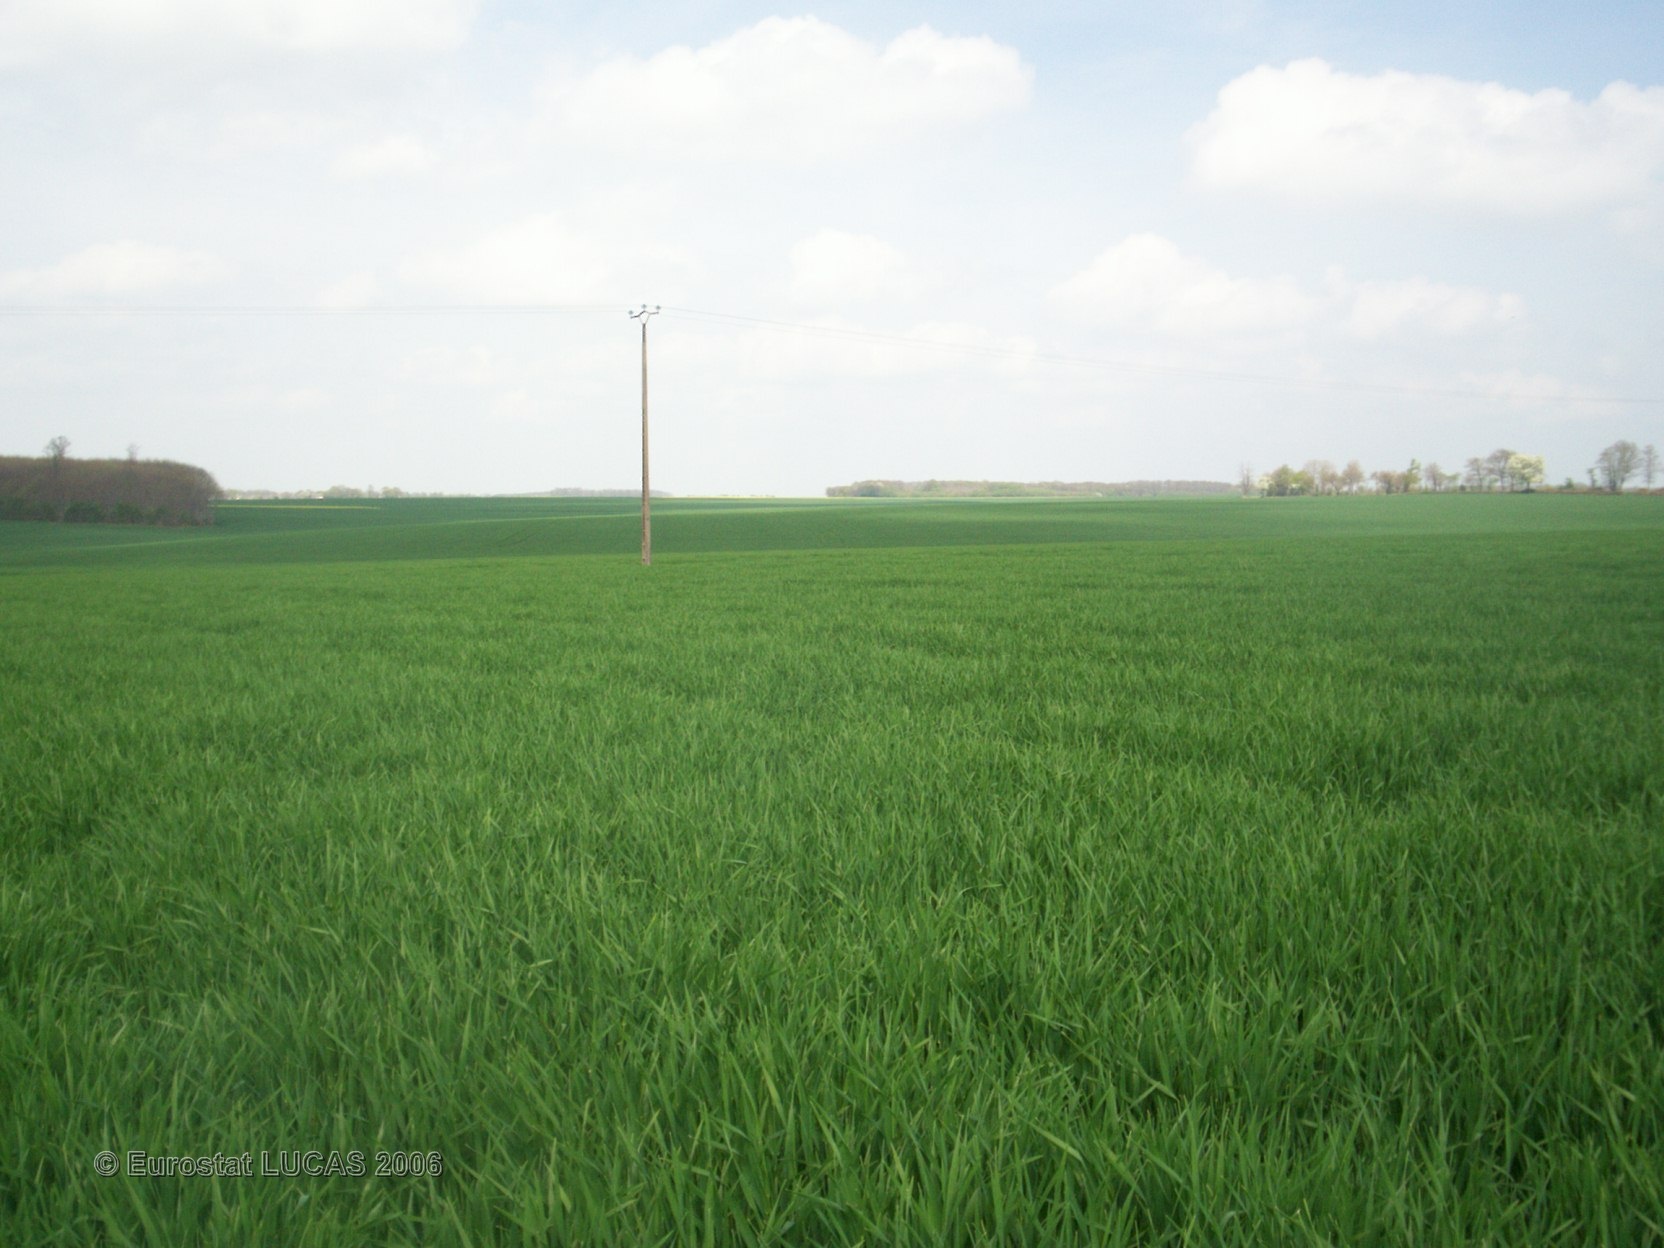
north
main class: Cropland
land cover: Barley
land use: Agriculture (excluding fallow land and kitchen gardens)
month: April
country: FR
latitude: 47.8248
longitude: 0.8571
